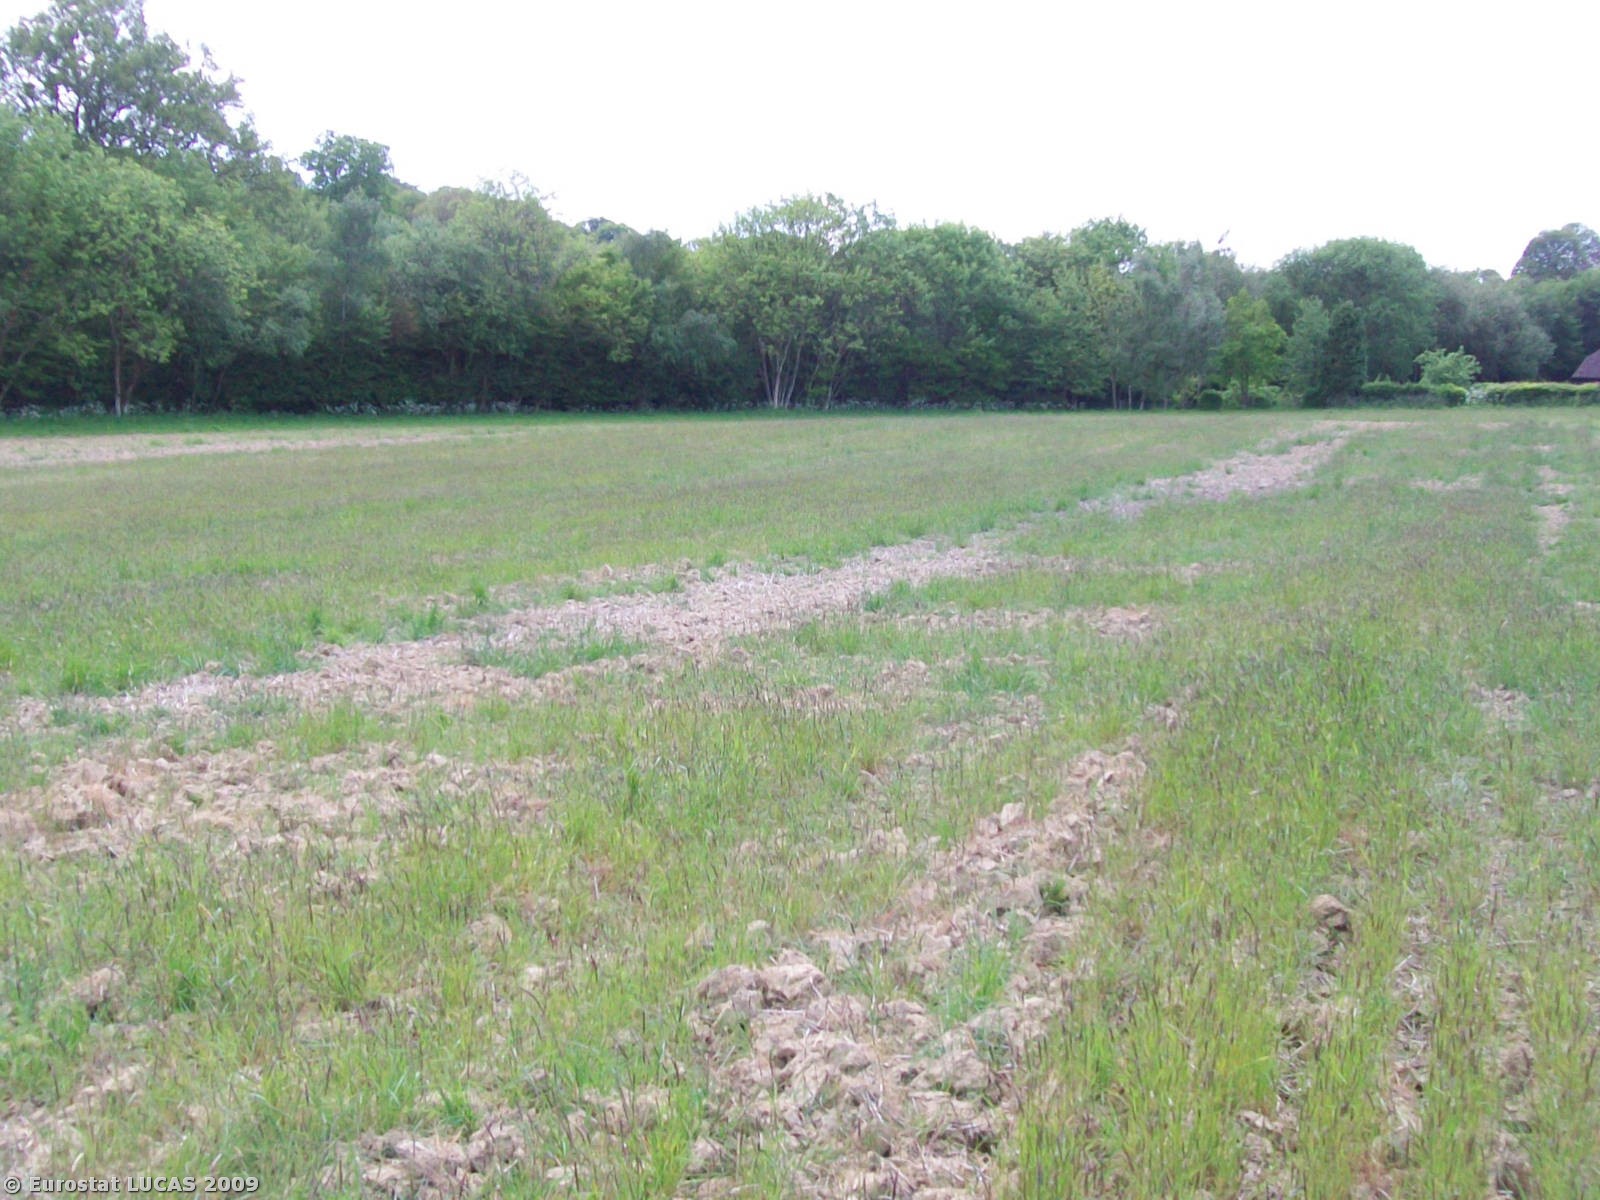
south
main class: Grassland
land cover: Grassland without tree/shrub cover
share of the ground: 50 - 75 %
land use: Agriculture (excluding fallow land and kitchen gardens)
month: May
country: GB
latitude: 51.2370
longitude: 0.3022
